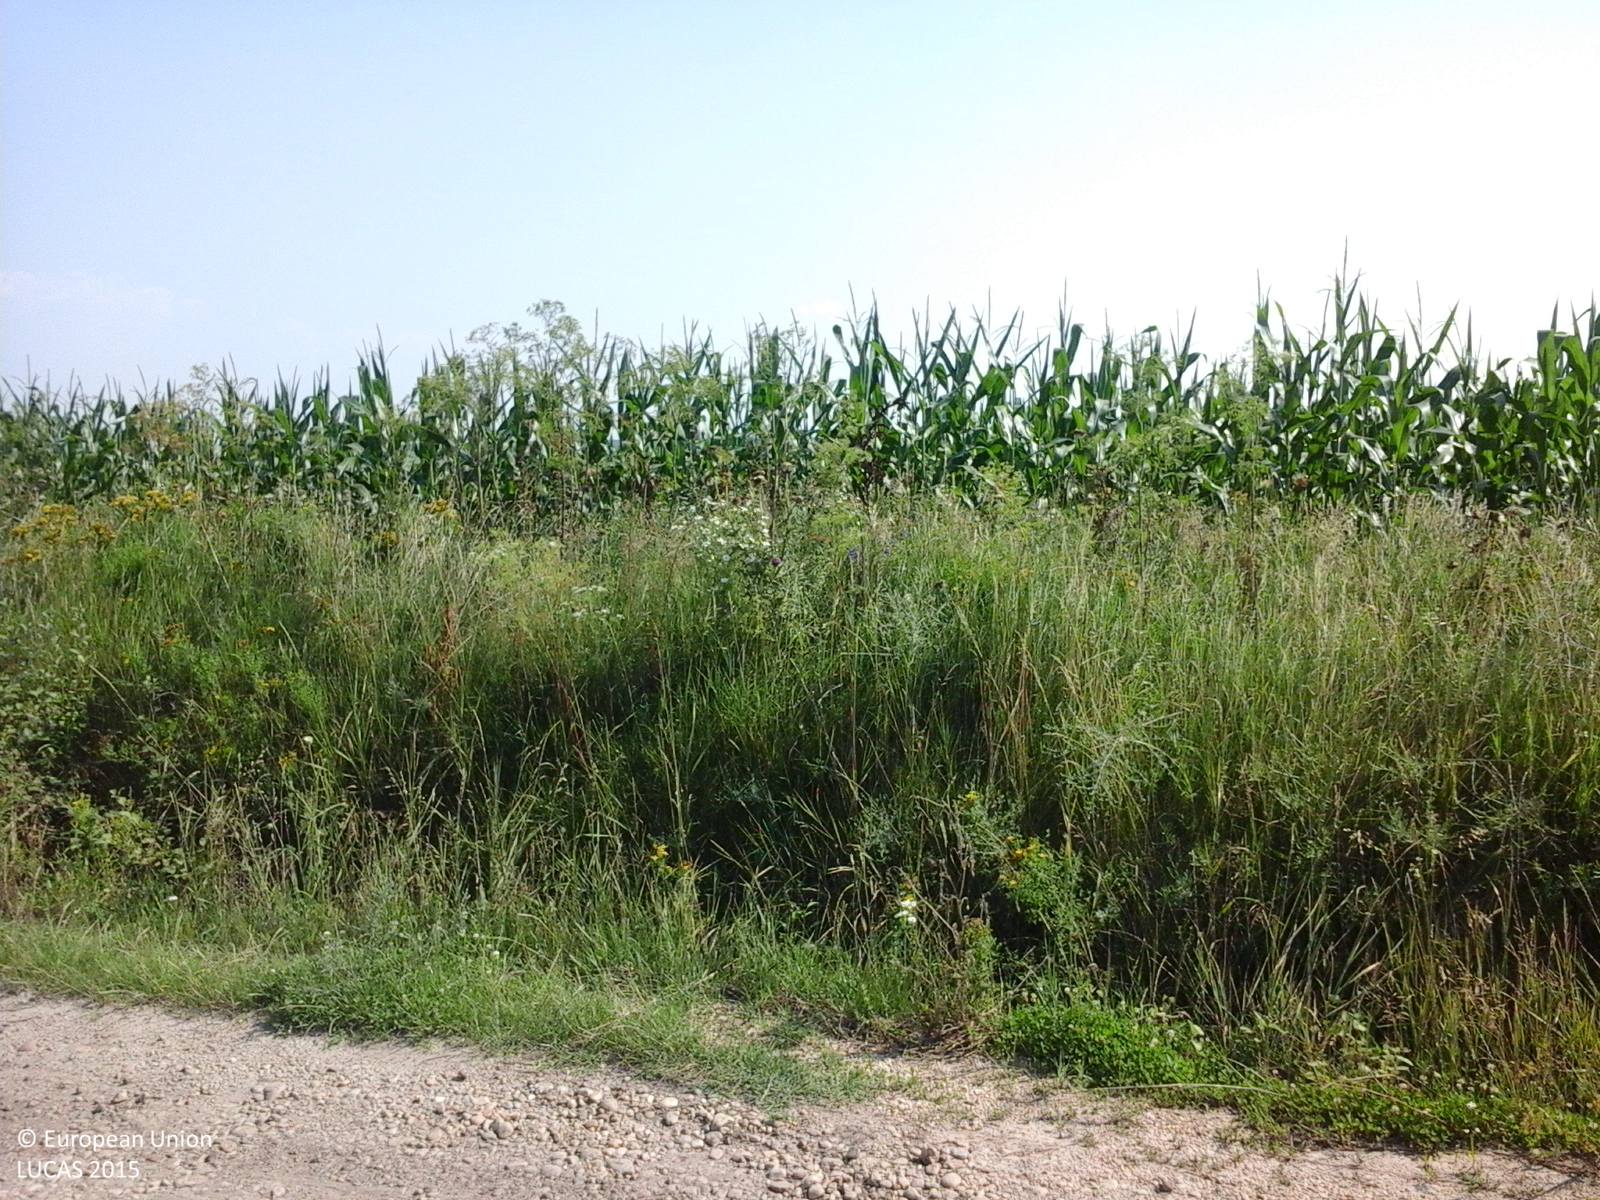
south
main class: Cropland
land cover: Common wheat
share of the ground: > 75 %
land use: Agriculture (excluding fallow land and kitchen gardens)
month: July
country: RO
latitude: 44.5749
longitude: 24.9790
